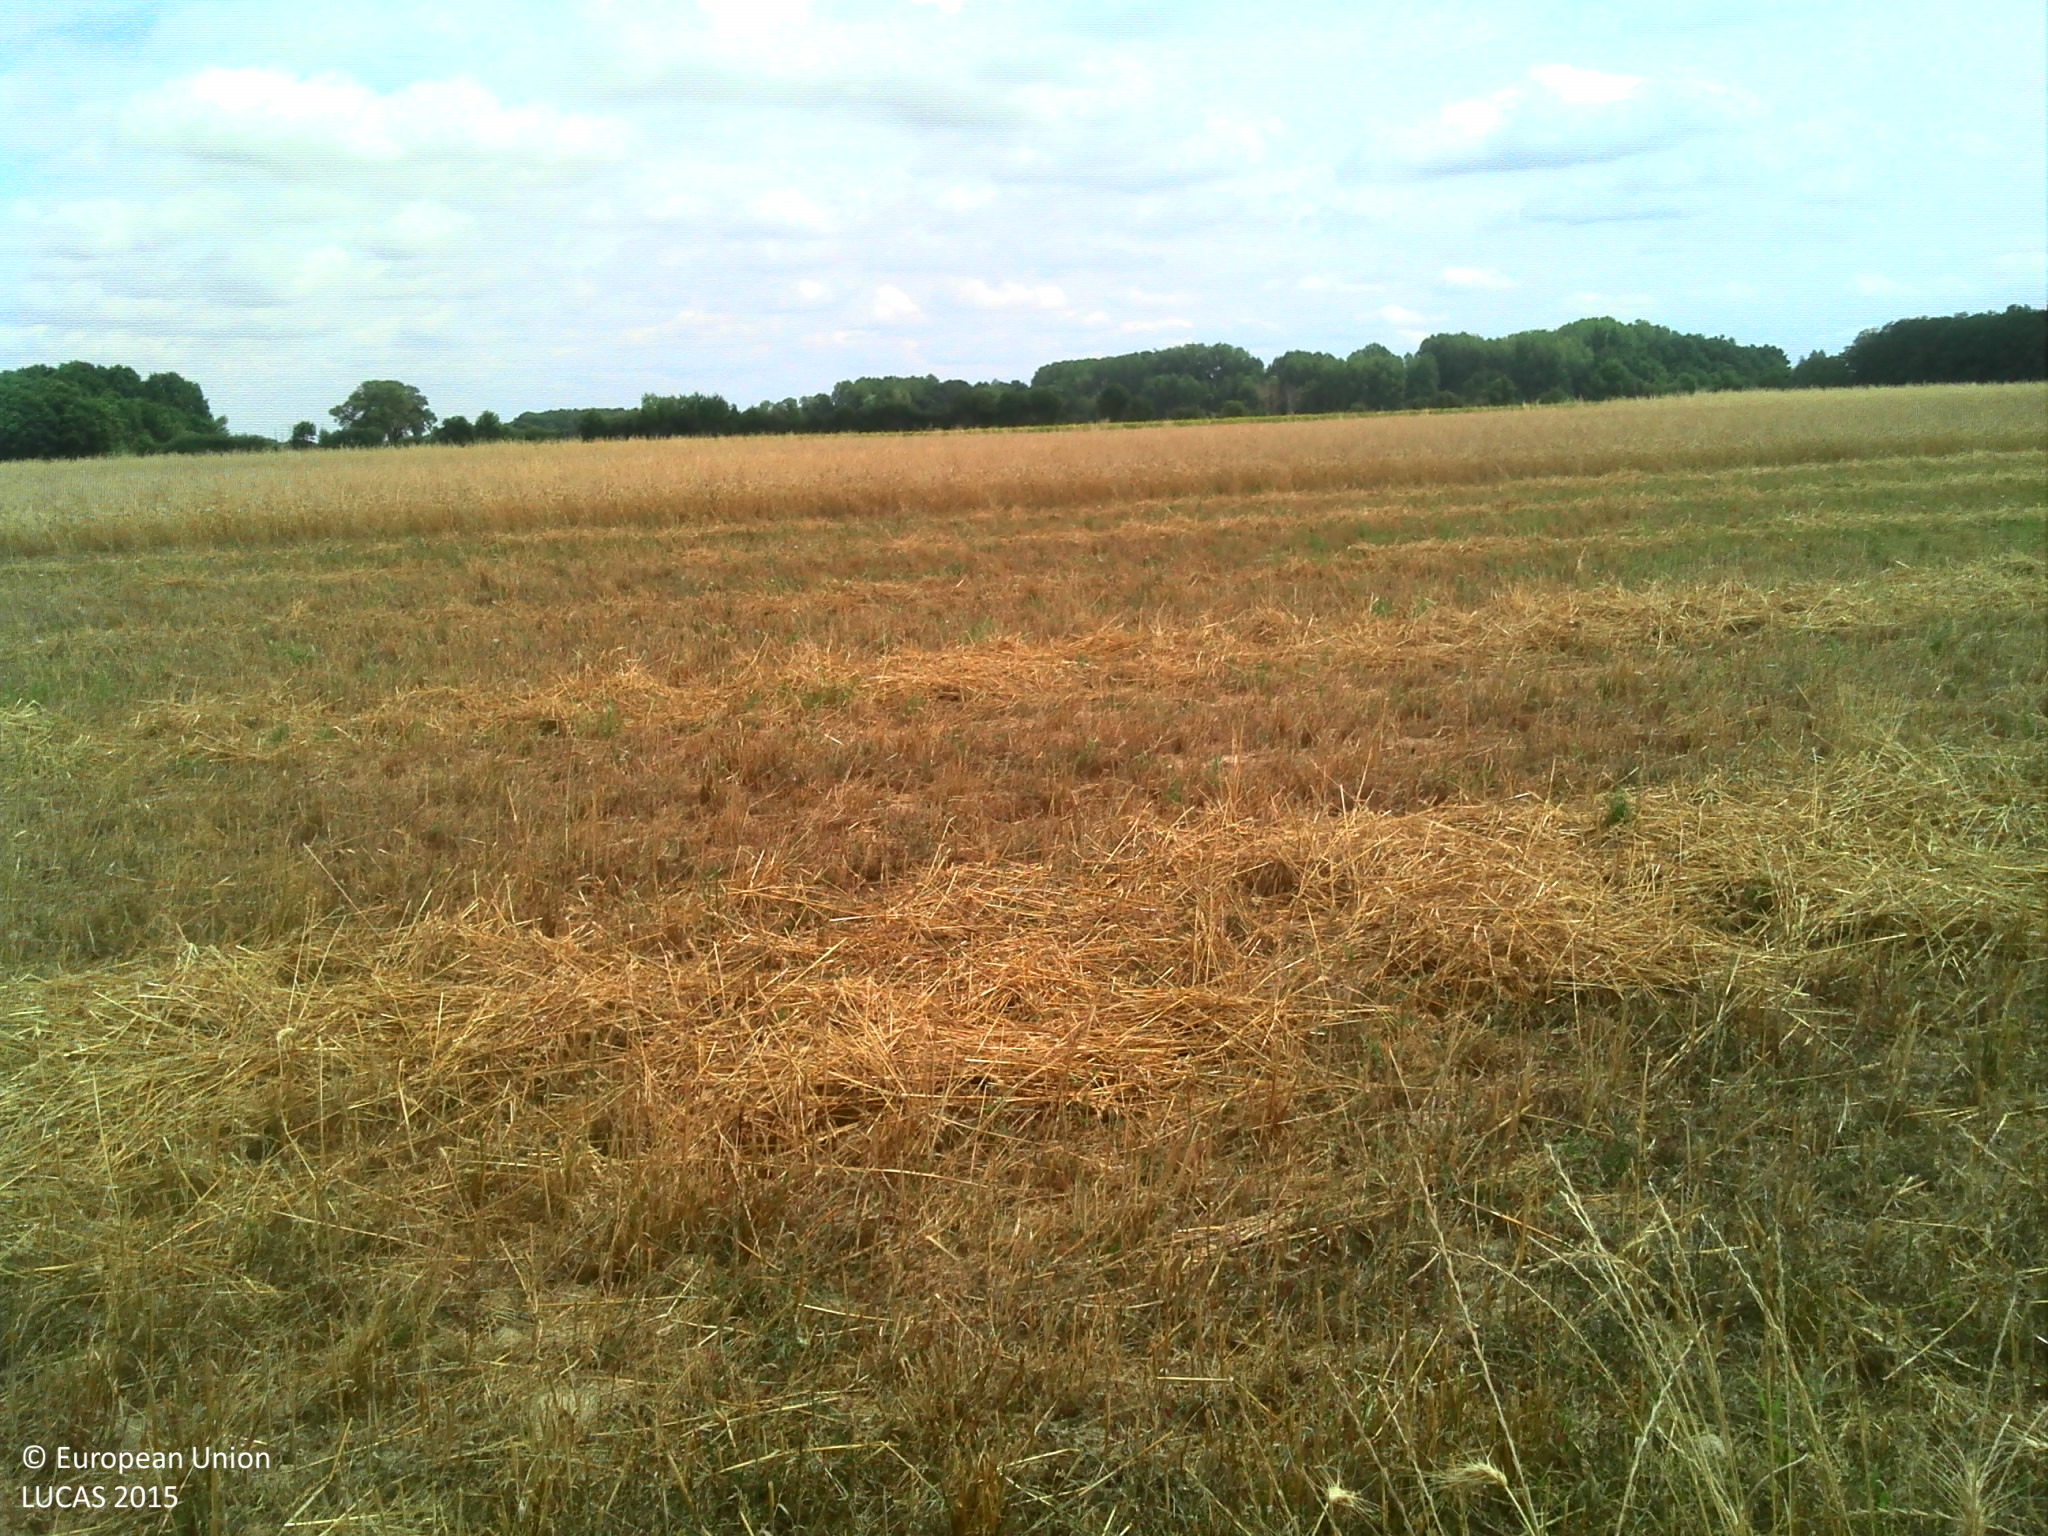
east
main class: Cropland
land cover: Common wheat
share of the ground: > 75 %
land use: Agriculture (excluding fallow land and kitchen gardens)
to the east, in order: Common wheat; Grass margins; Sunflower
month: July
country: FR
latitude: 47.1267
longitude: 0.7412
